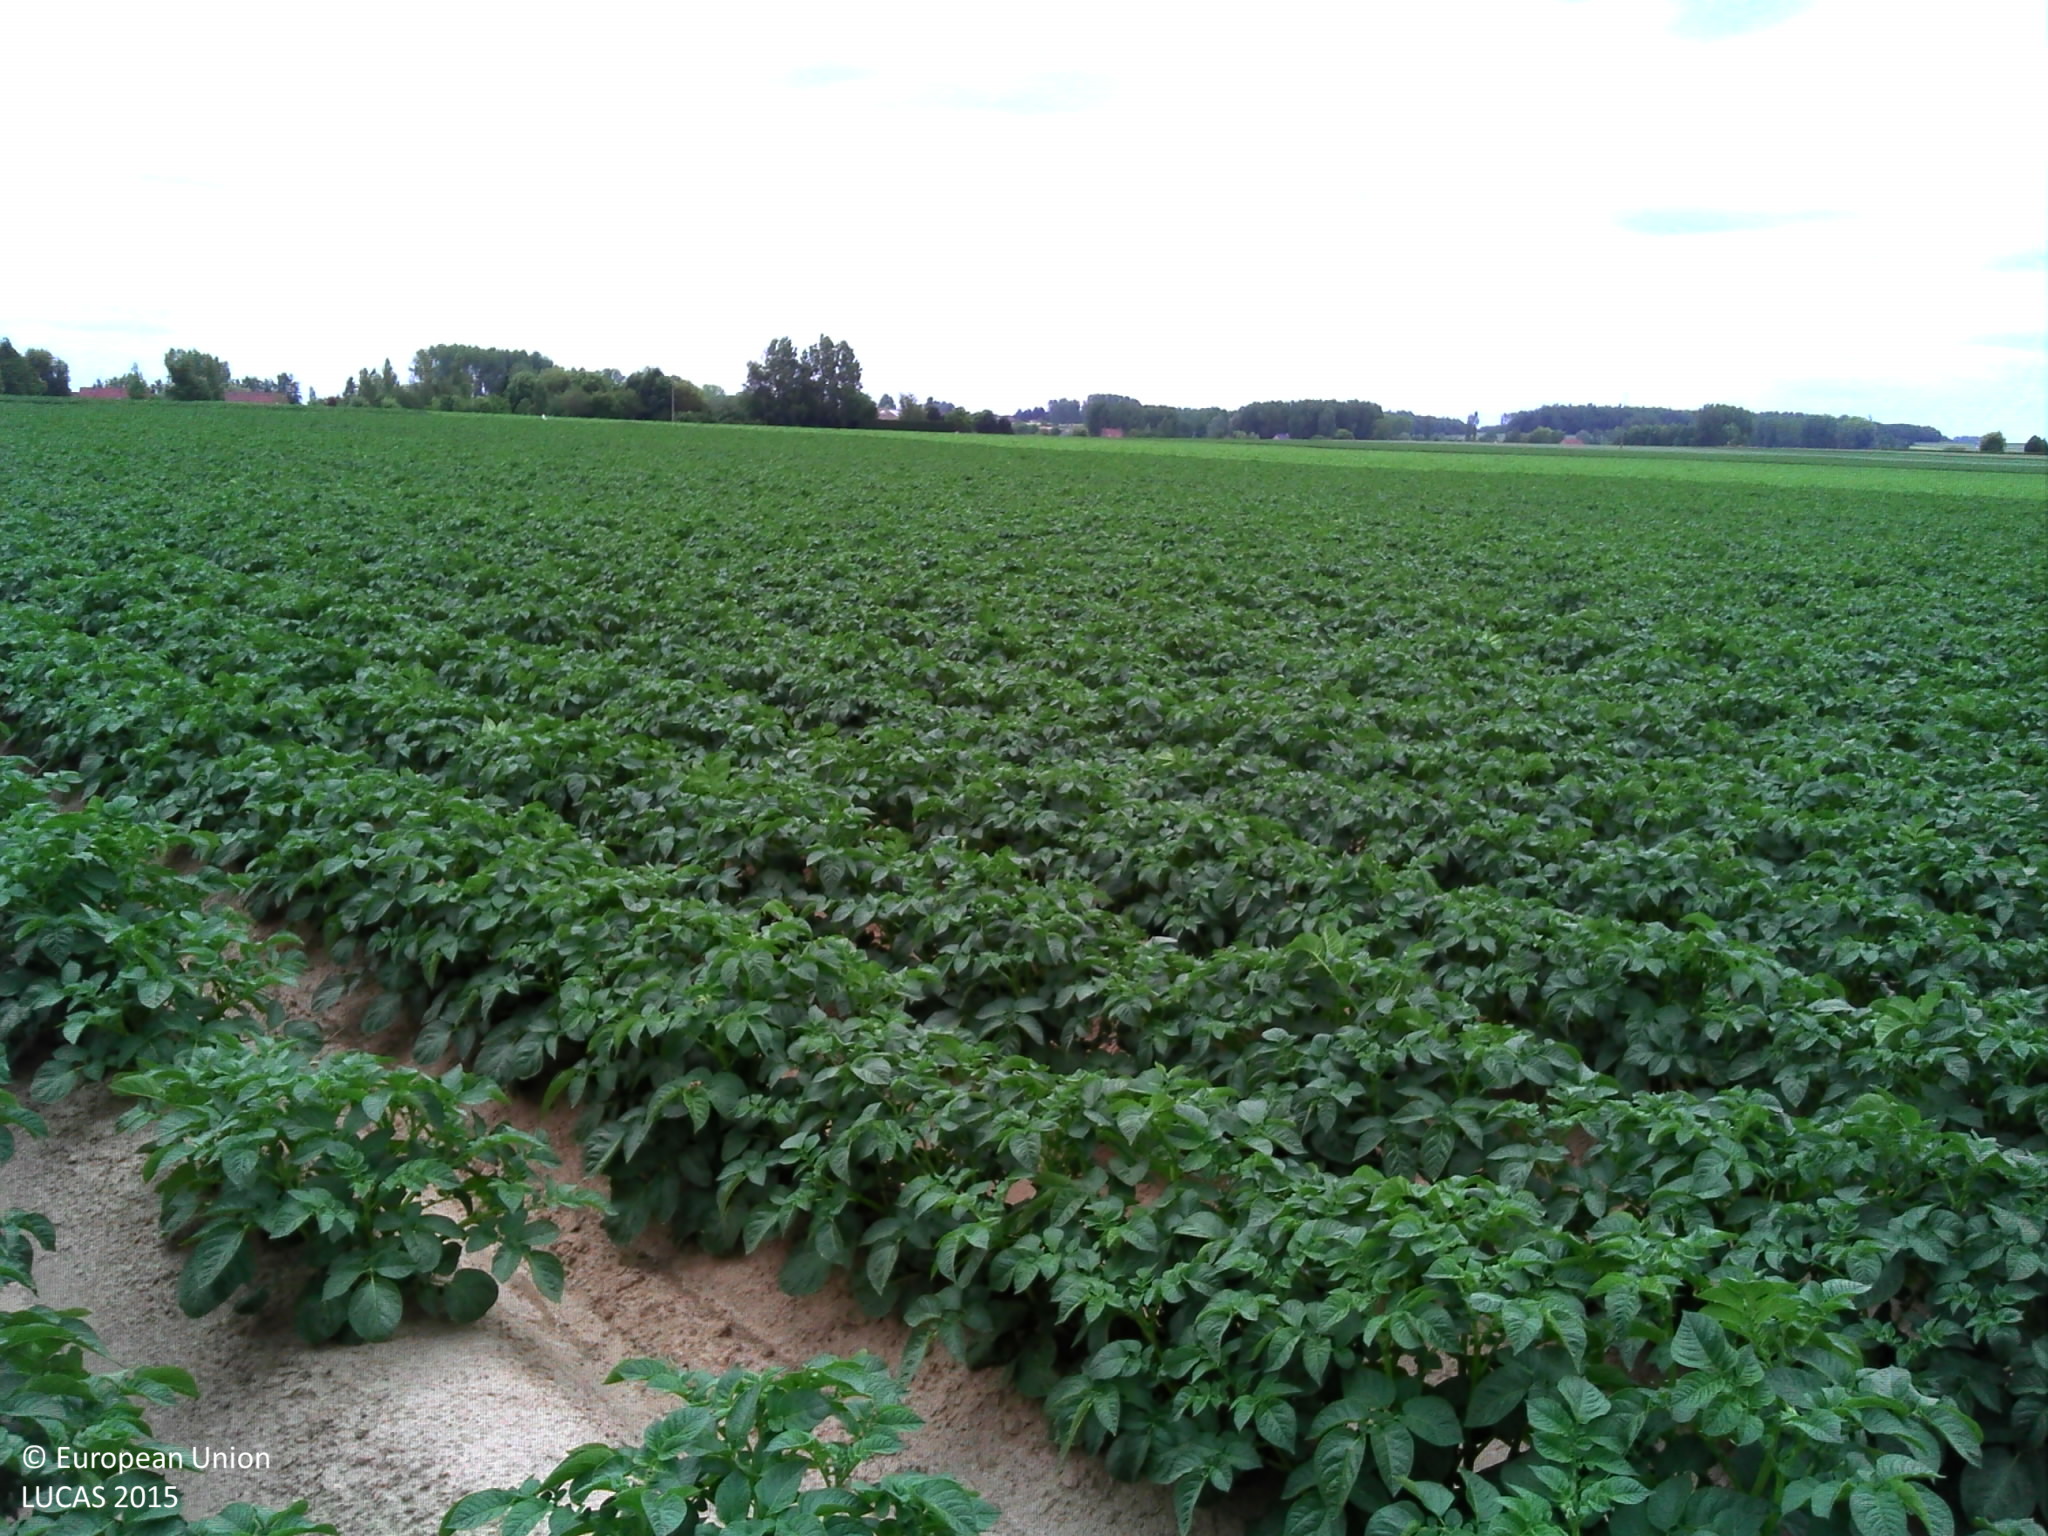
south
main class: Cropland
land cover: Potatoes
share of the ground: > 75 %
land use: Agriculture (excluding fallow land and kitchen gardens)
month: June
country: FR
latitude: 50.6843
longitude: 2.3292
